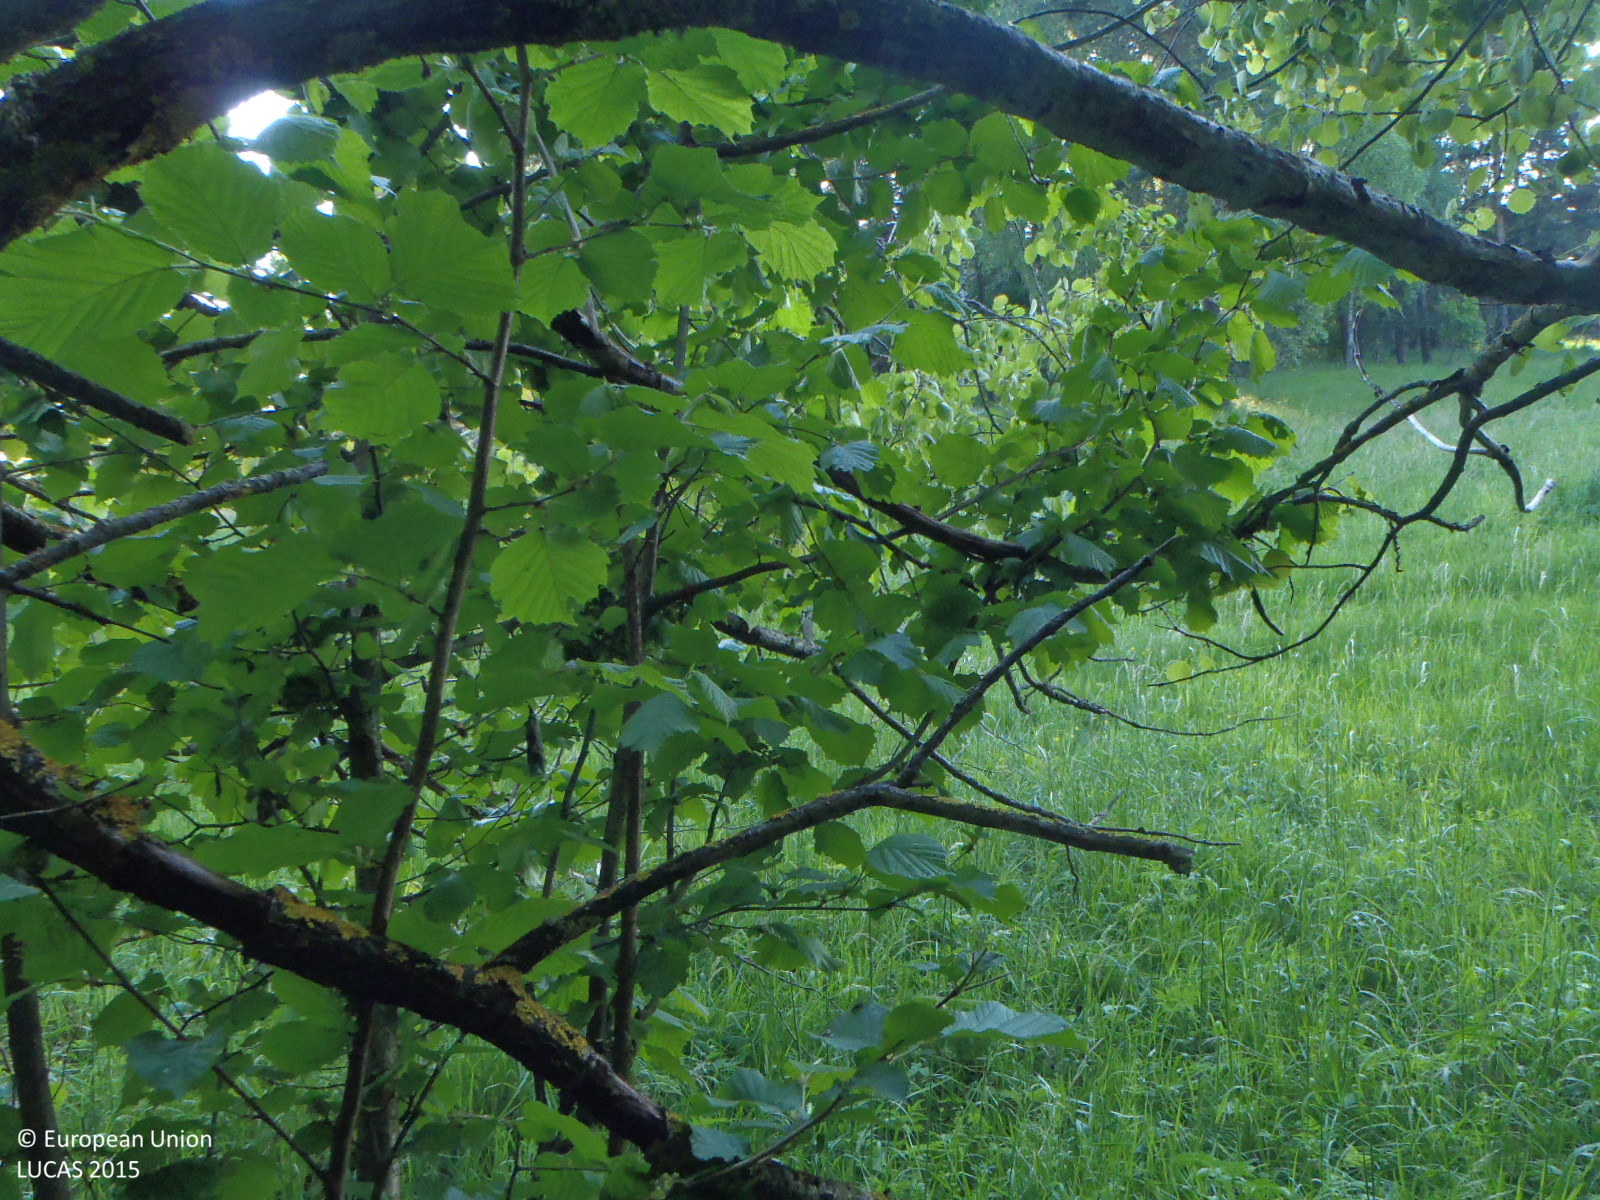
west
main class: Woodland
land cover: Broadleaved woodland
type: non-riverine alder, birch or aspen forest
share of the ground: > 75 %
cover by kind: broadleaved forest trees 100 %
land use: Semi-natural and natural areas not in use
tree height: > 5 m
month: May
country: CZ
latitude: 48.6355
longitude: 14.5197
